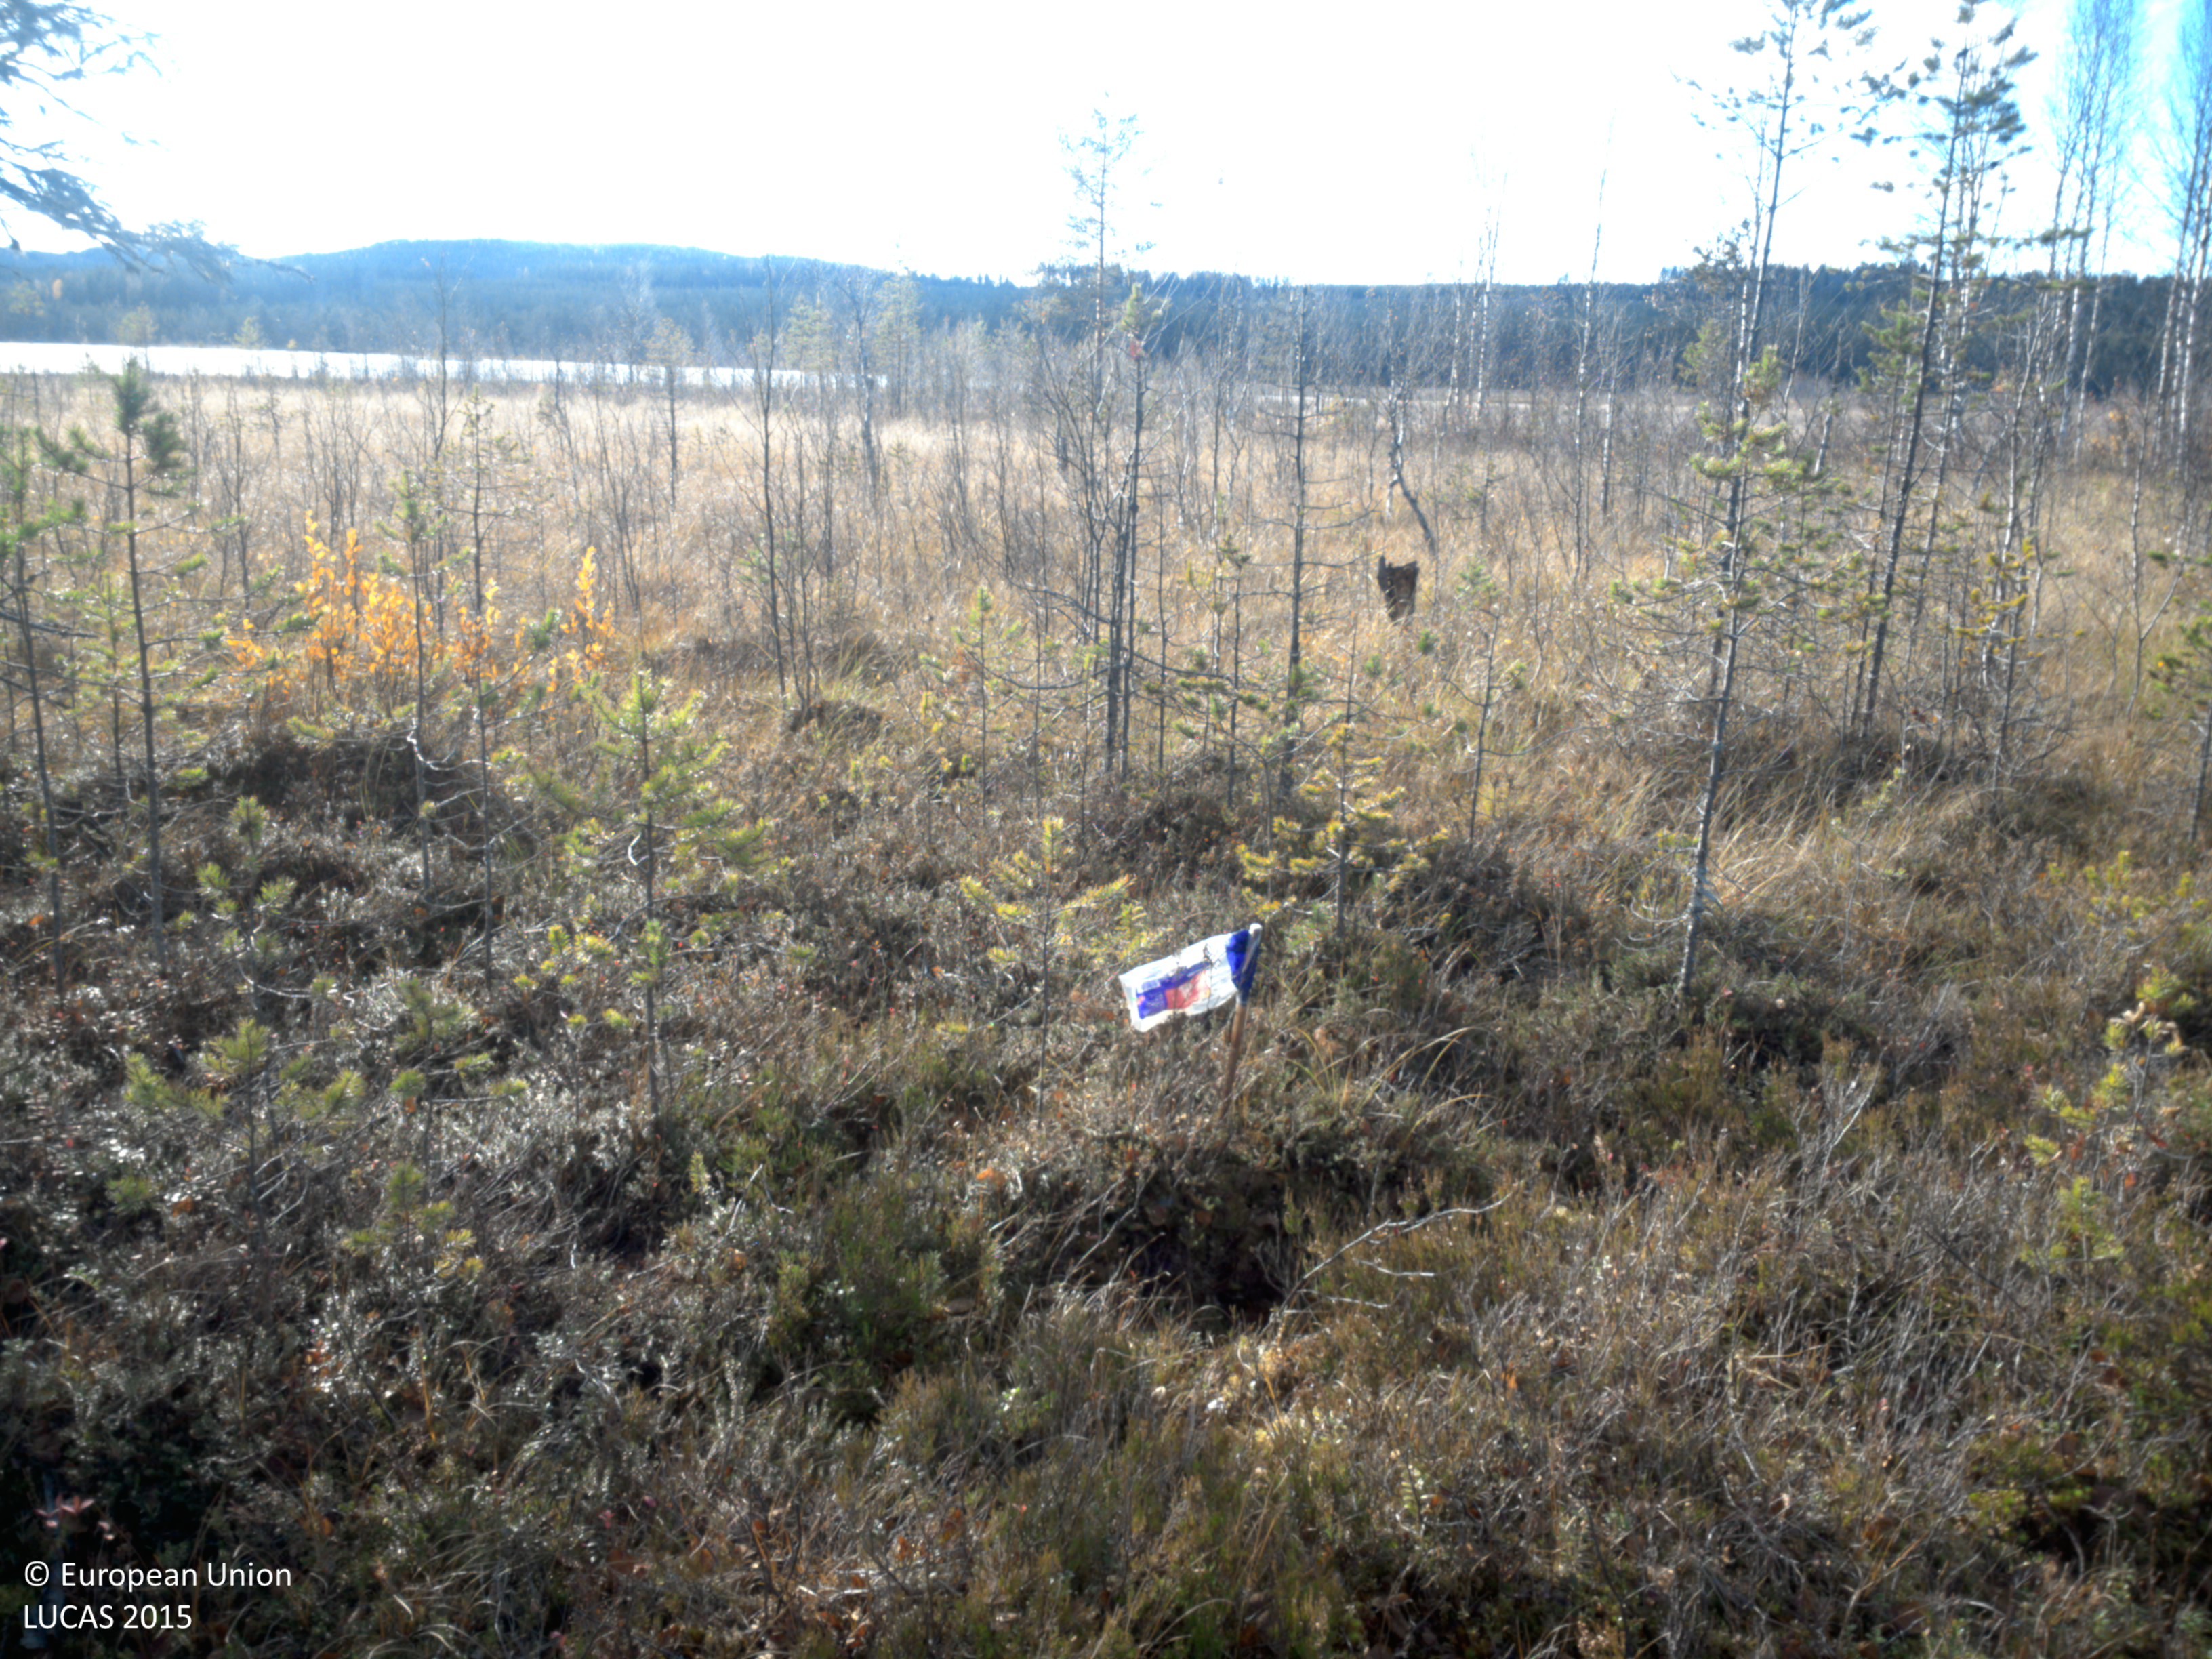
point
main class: Woodland
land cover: Pine dominated mixed woodland
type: boreal forest
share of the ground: 25 - 50 %
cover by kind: shrubs 35 %, herbaceous plants 20 %, coniferous forest trees 15 %, broadleaved forest trees 15 %, lichens and mosses 15 %
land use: Forestry
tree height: > 5 m
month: October
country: SE
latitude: 64.7733
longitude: 18.4406
